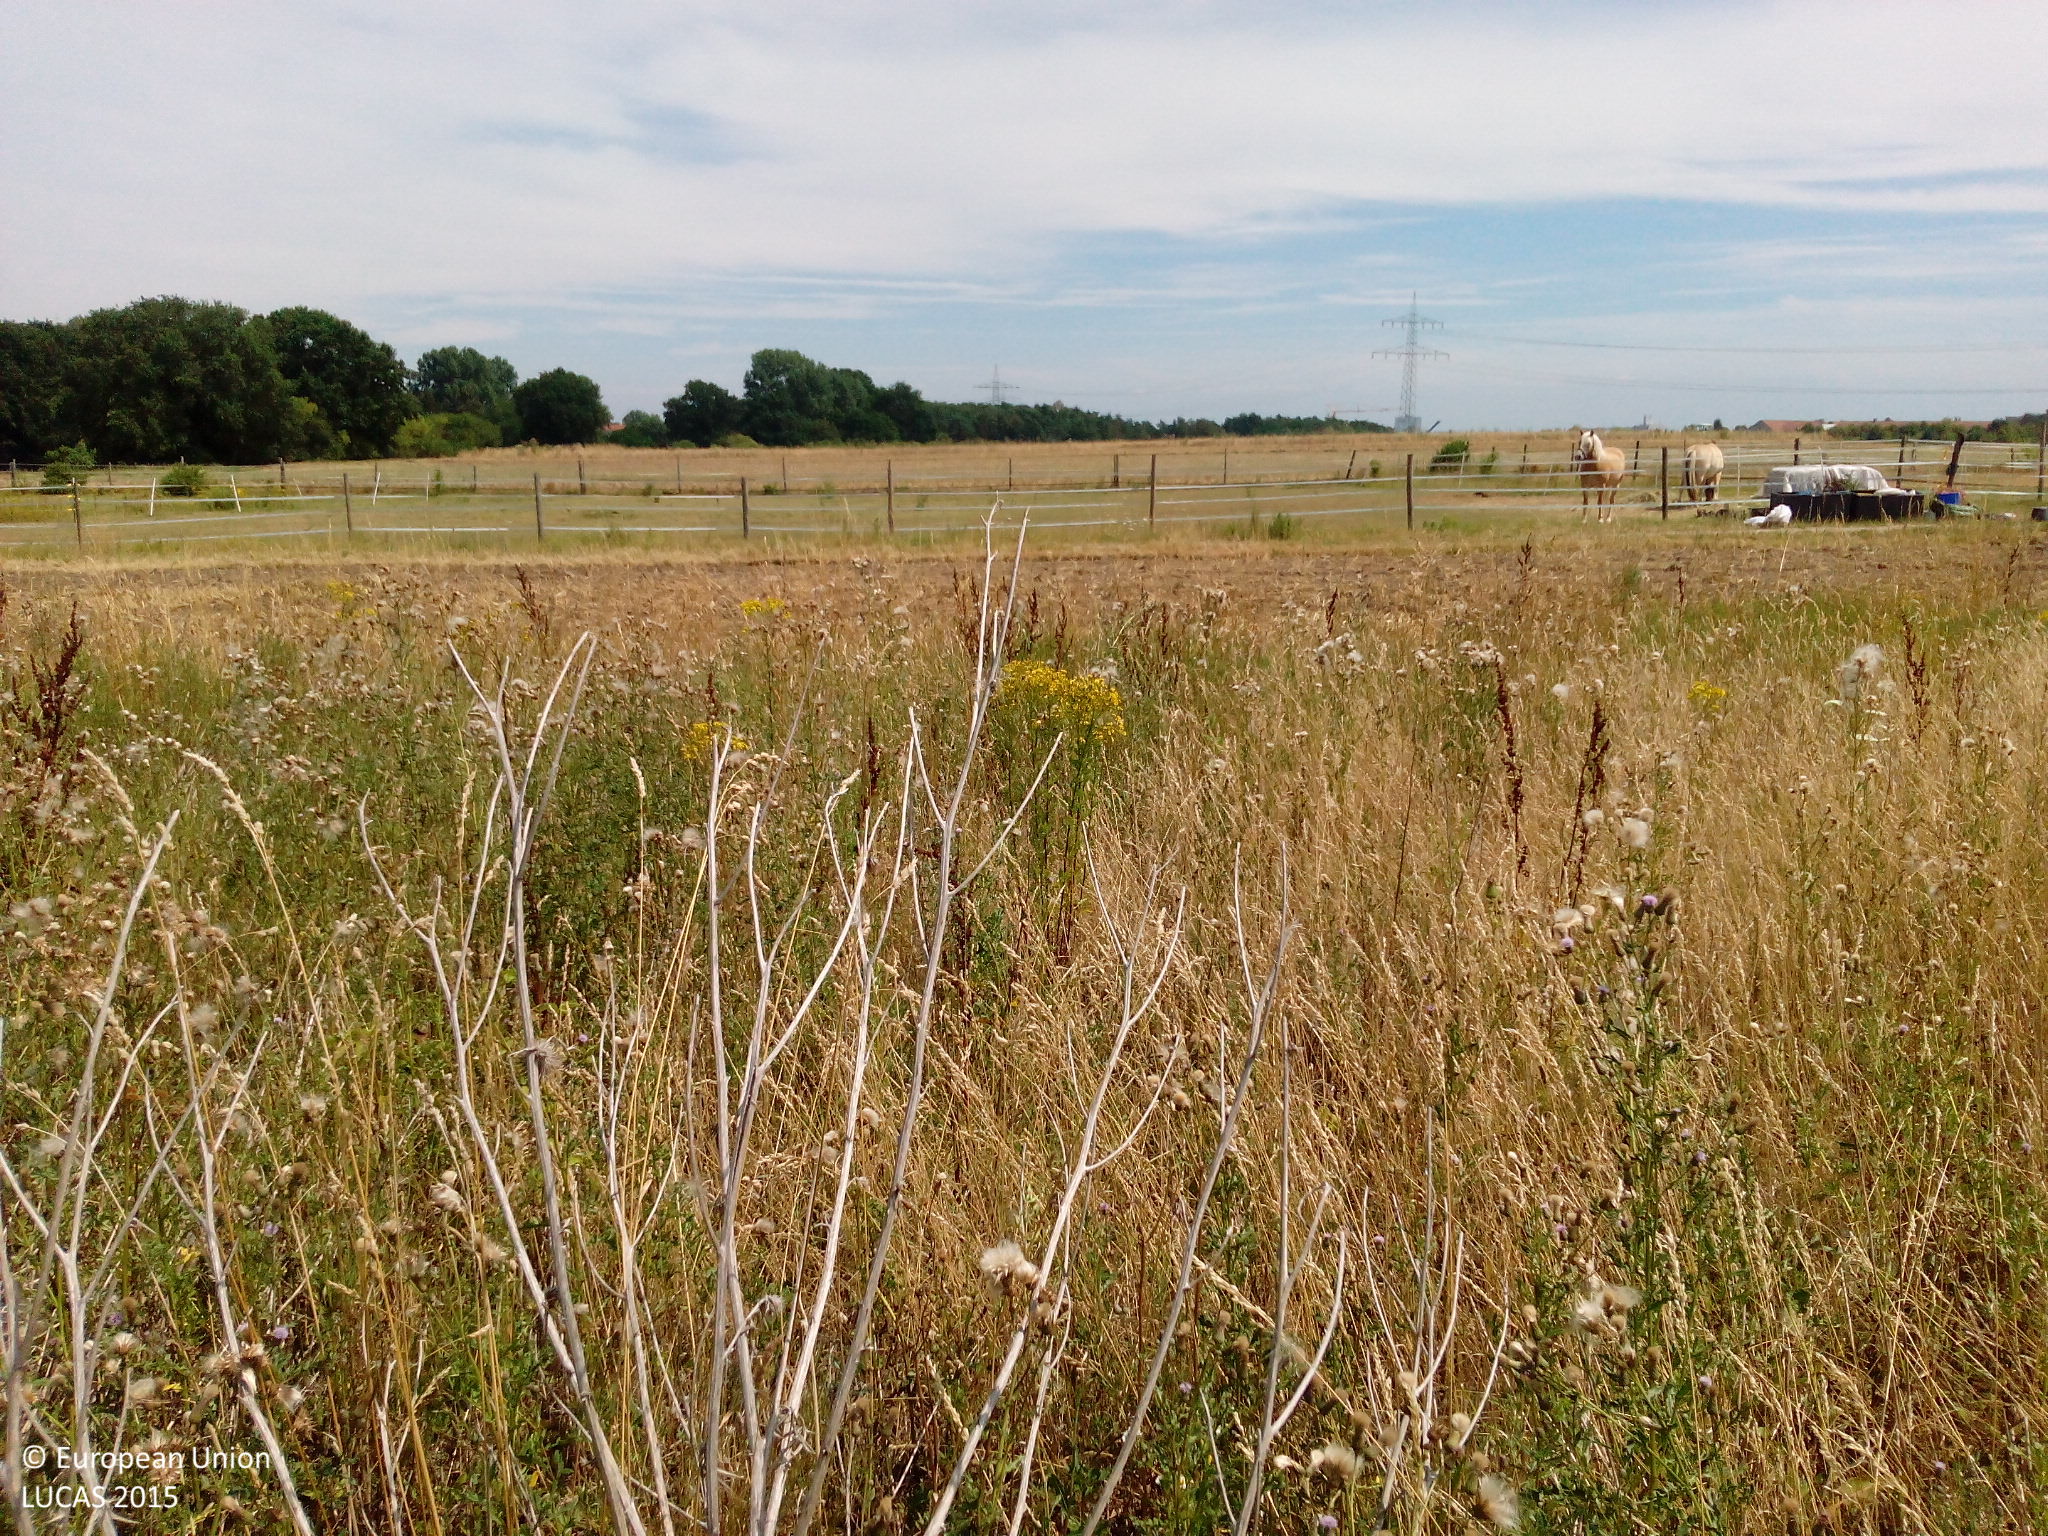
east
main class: Cropland
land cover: Temporary grasslands
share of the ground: > 75 %
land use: Agriculture (excluding fallow land and kitchen gardens)
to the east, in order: Temporary grasslands; Barley; Tracks; Grass margins; Fences; Grassland without tree/shrub cover; Fences; Barley; Other bare soil; Barley; Spontaneously vegetated surfaces; Temporary grasslands
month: July
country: DE
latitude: 49.5867
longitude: 10.9541
